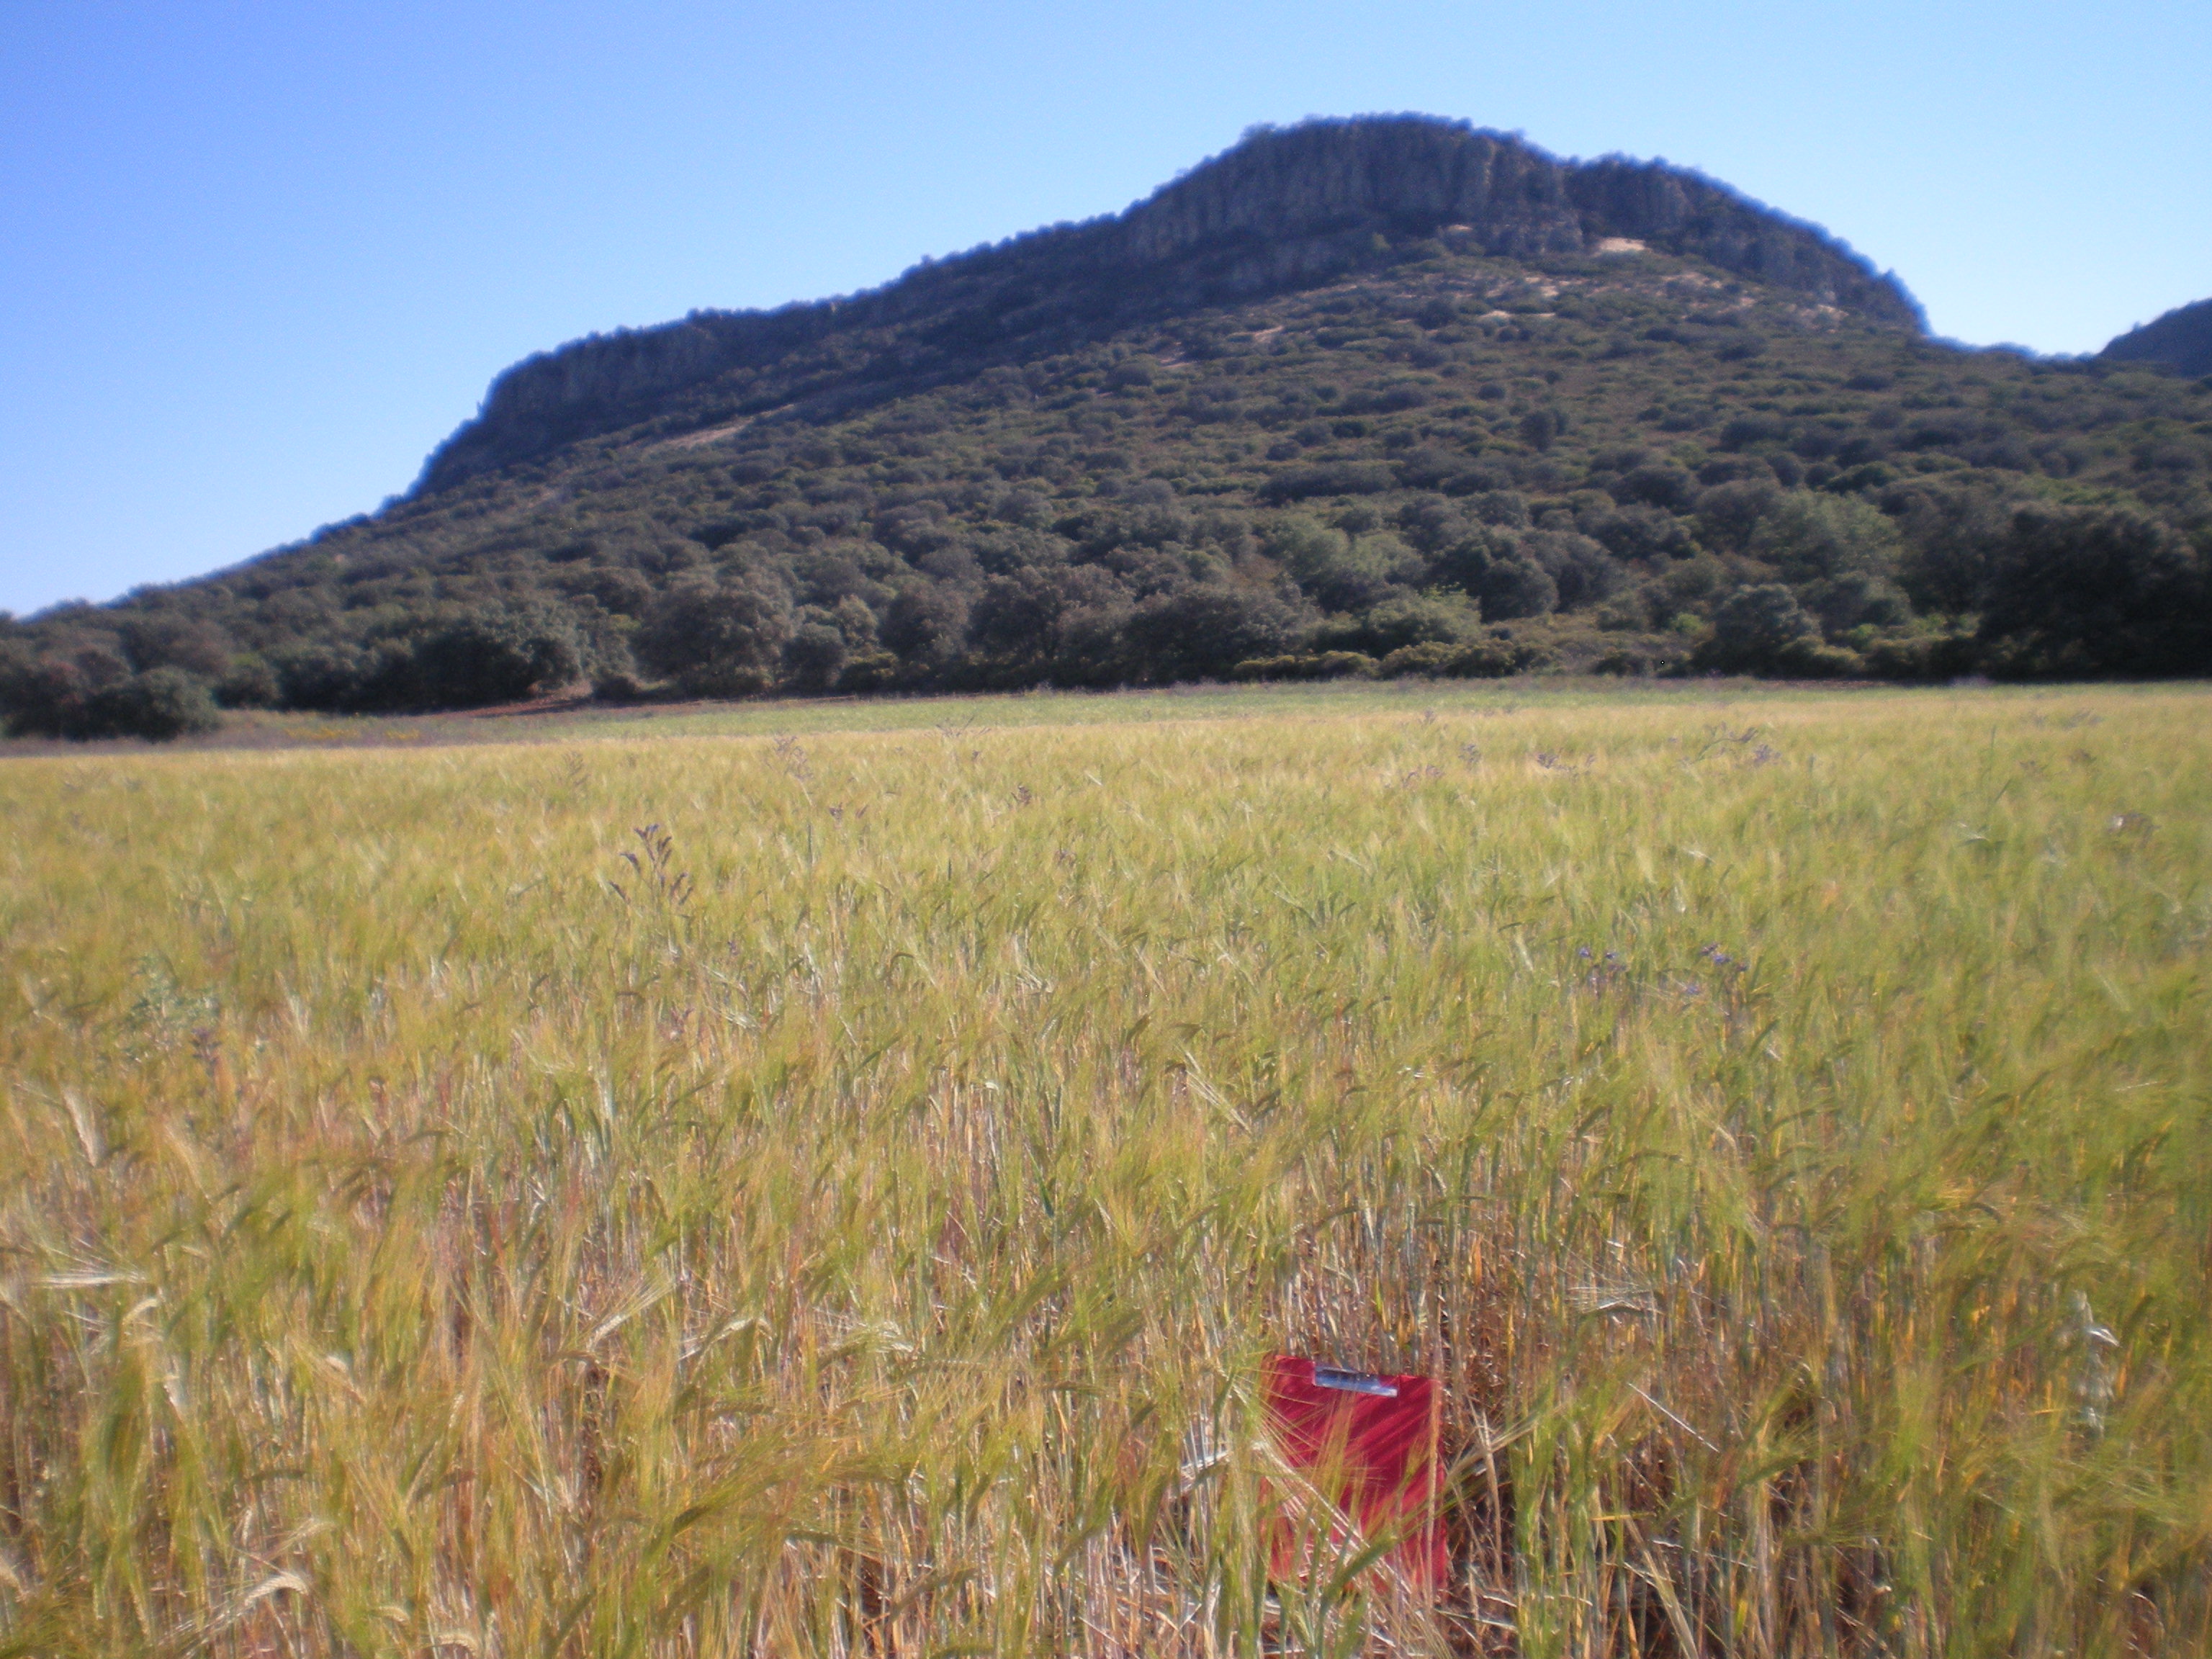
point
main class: Cropland
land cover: Barley
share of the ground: > 75 %
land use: Agriculture (excluding fallow land and kitchen gardens)
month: May
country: ES
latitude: 38.5724
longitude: -3.1481
